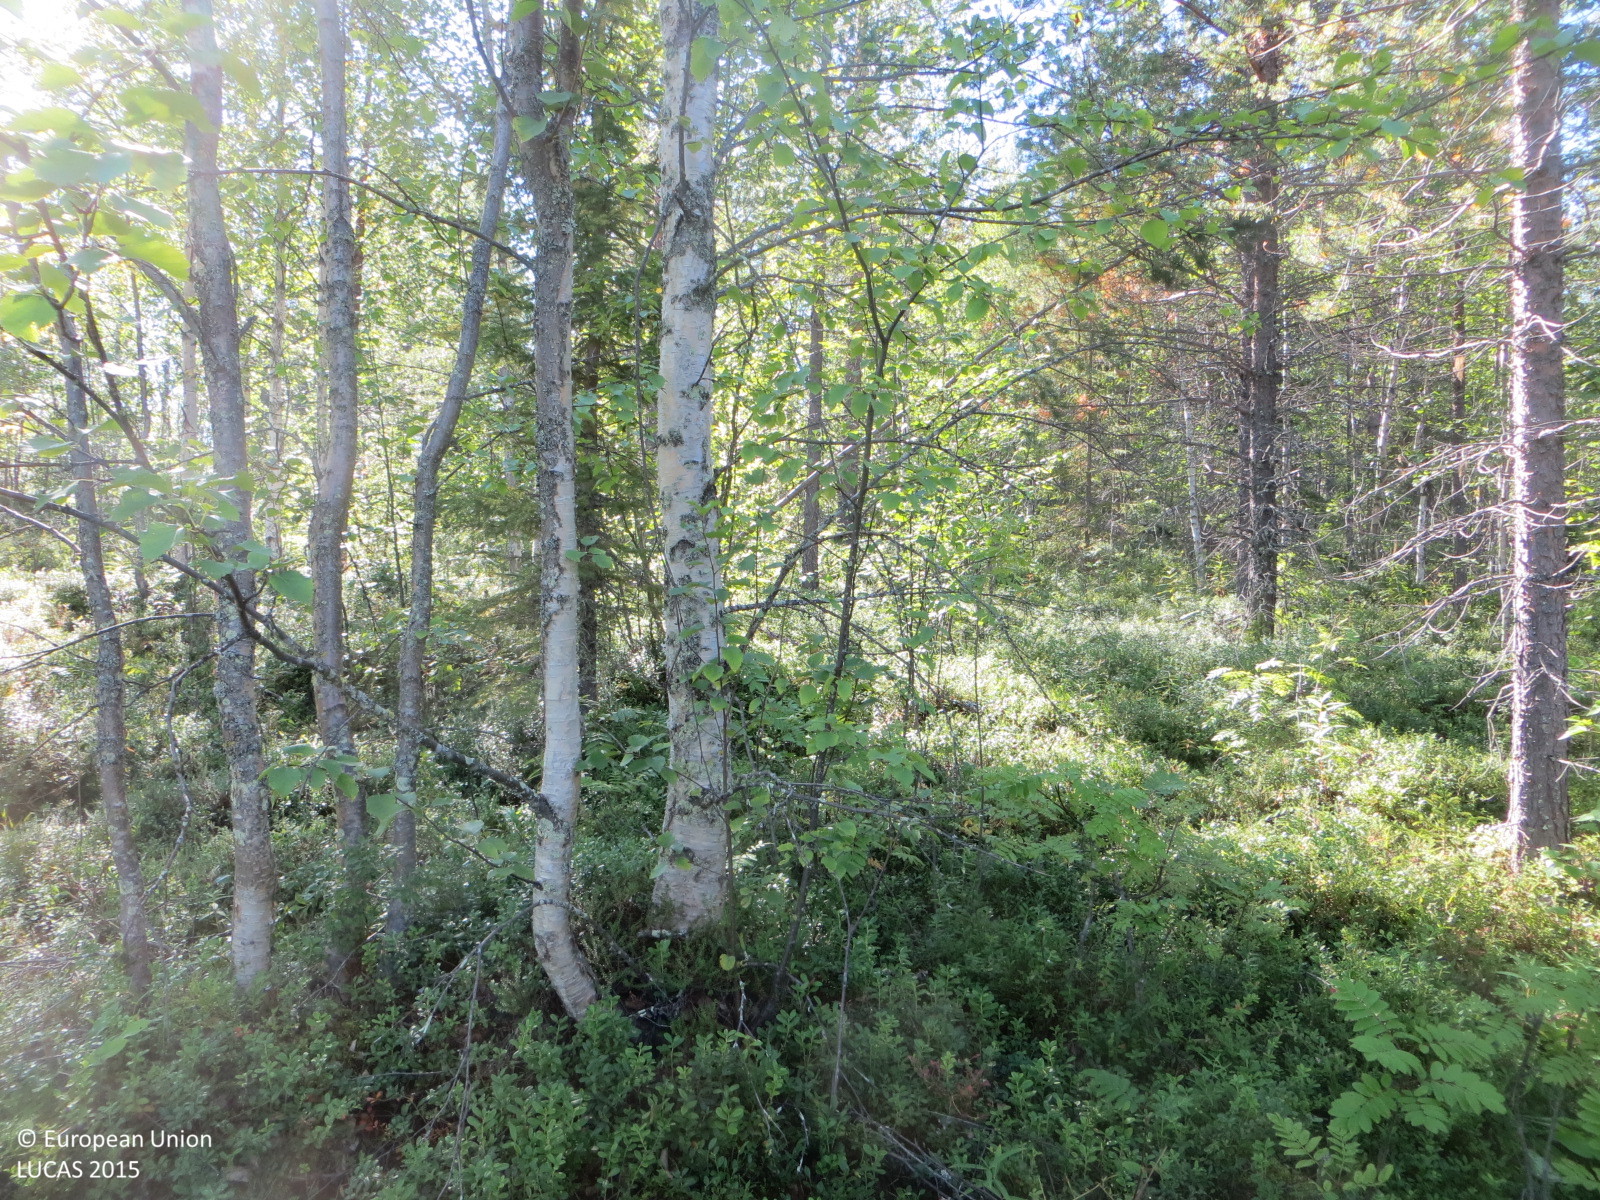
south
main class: Woodland
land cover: Pine dominated mixed woodland
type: boreal forest
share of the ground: 50 - 75 %
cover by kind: shrubs 40 %, broadleaved forest trees 35 %, coniferous forest trees 25 %
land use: Forestry
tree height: > 5 m
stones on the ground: 25 - 50 %
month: August
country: FI
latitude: 67.1941
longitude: 24.1083
